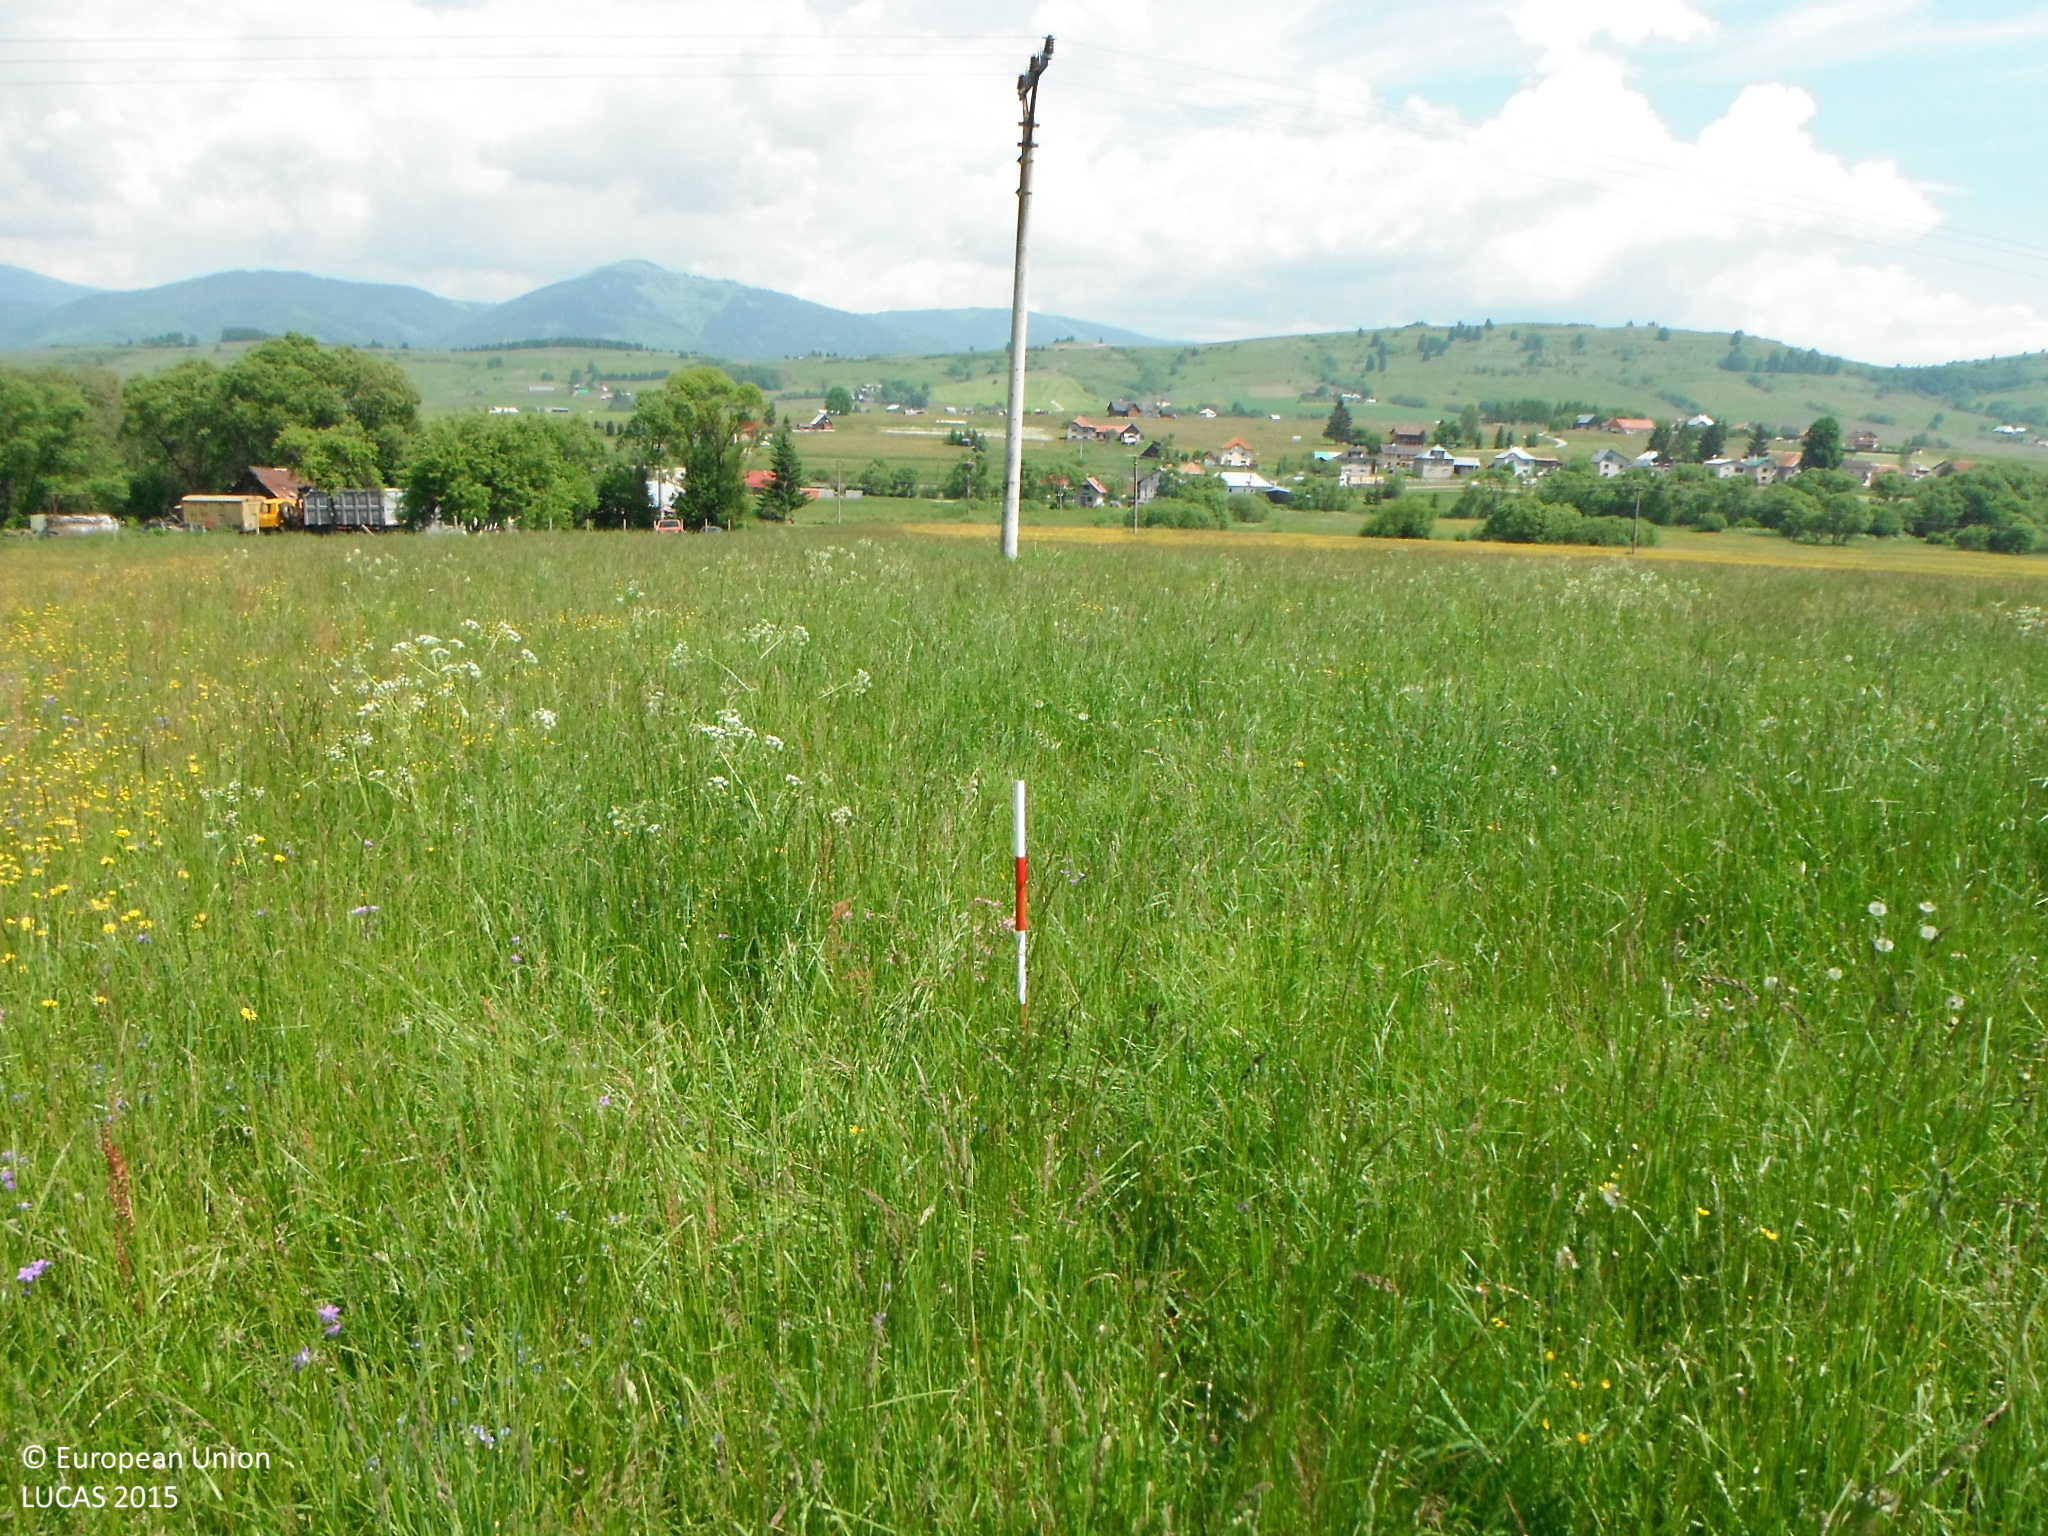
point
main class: Grassland
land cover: Grassland without tree/shrub cover
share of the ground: > 75 %
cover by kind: herbaceous plants 100 %
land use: Agriculture (excluding fallow land and kitchen gardens)
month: June
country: SK
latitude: 48.7910
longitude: 19.7054
